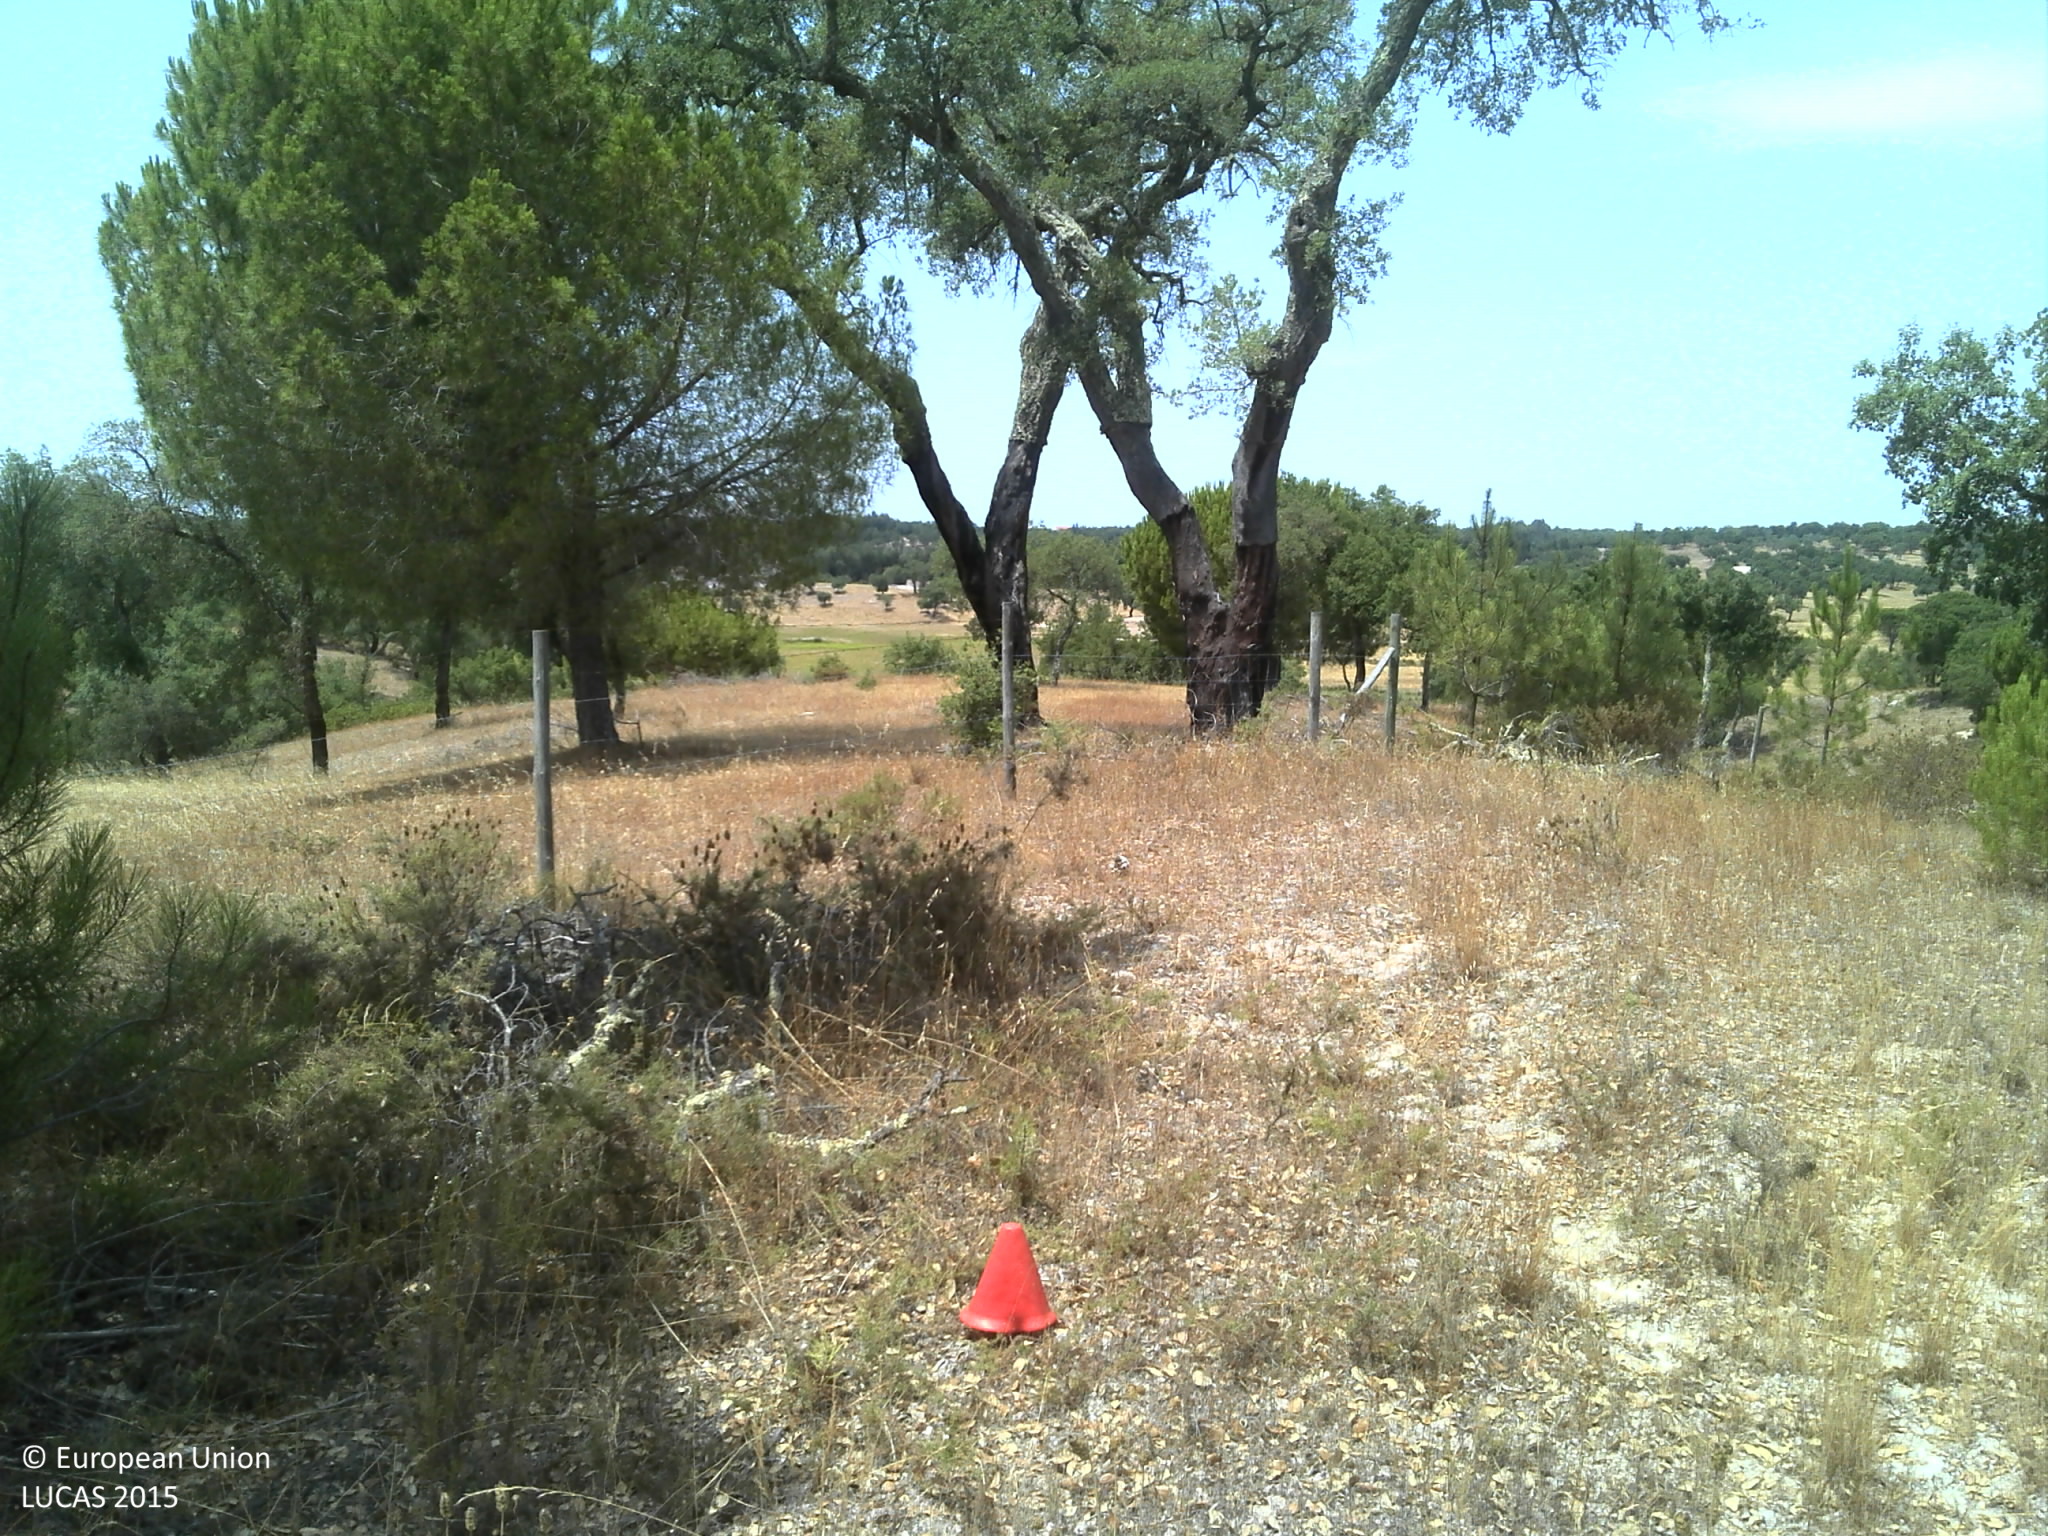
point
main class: Woodland
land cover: Broadleaved woodland
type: broadleaved evergreen forest
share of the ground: 25 - 50 %
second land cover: Grassland without tree/shrub cover
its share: 25 - 50 %
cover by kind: broadleaved forest trees 35 %, herbaceous plants 35 %, unconsolidated bare surface 30 %
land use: Forestry
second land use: Agriculture (excluding fallow land and kitchen gardens)
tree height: > 5 m
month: July
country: PT
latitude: 39.1518
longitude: -8.2376
